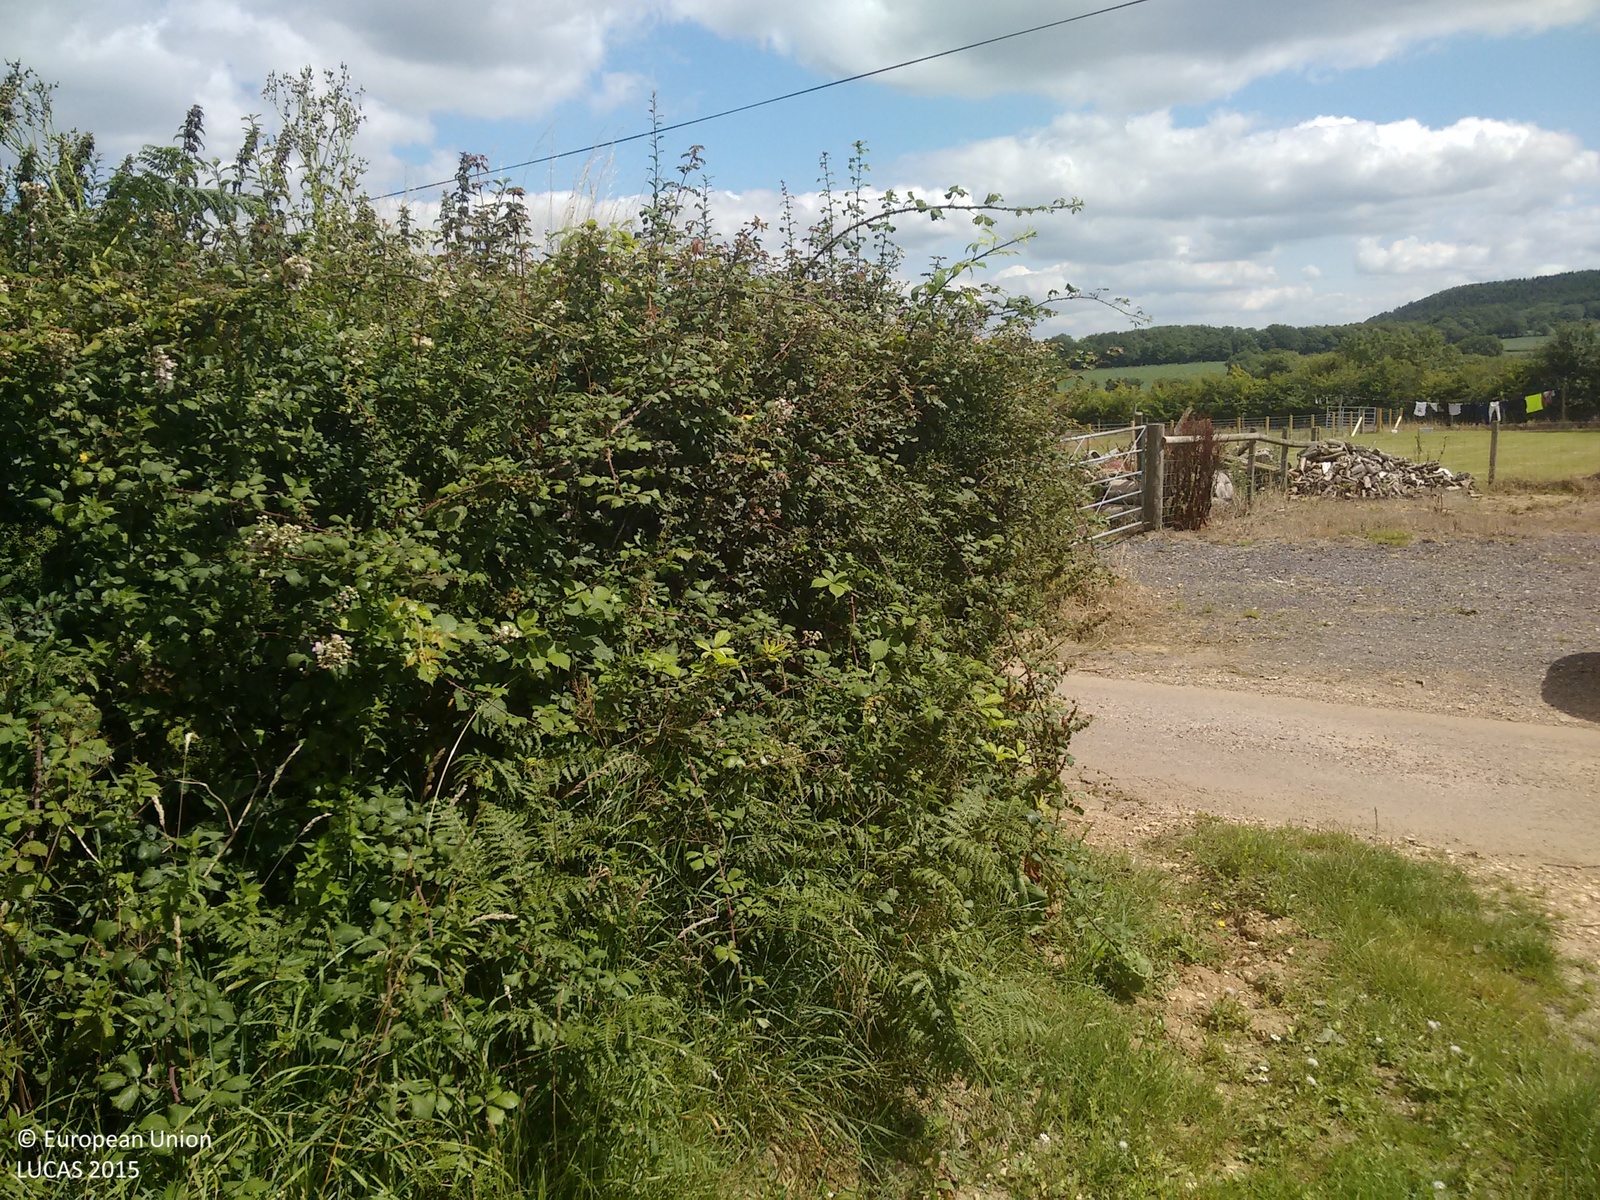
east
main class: Cropland
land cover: Maize
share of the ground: > 75 %
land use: Agriculture (excluding fallow land and kitchen gardens)
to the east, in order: Maize; Electric lines; Maize
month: July
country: GB
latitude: 50.7863
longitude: -3.1412
